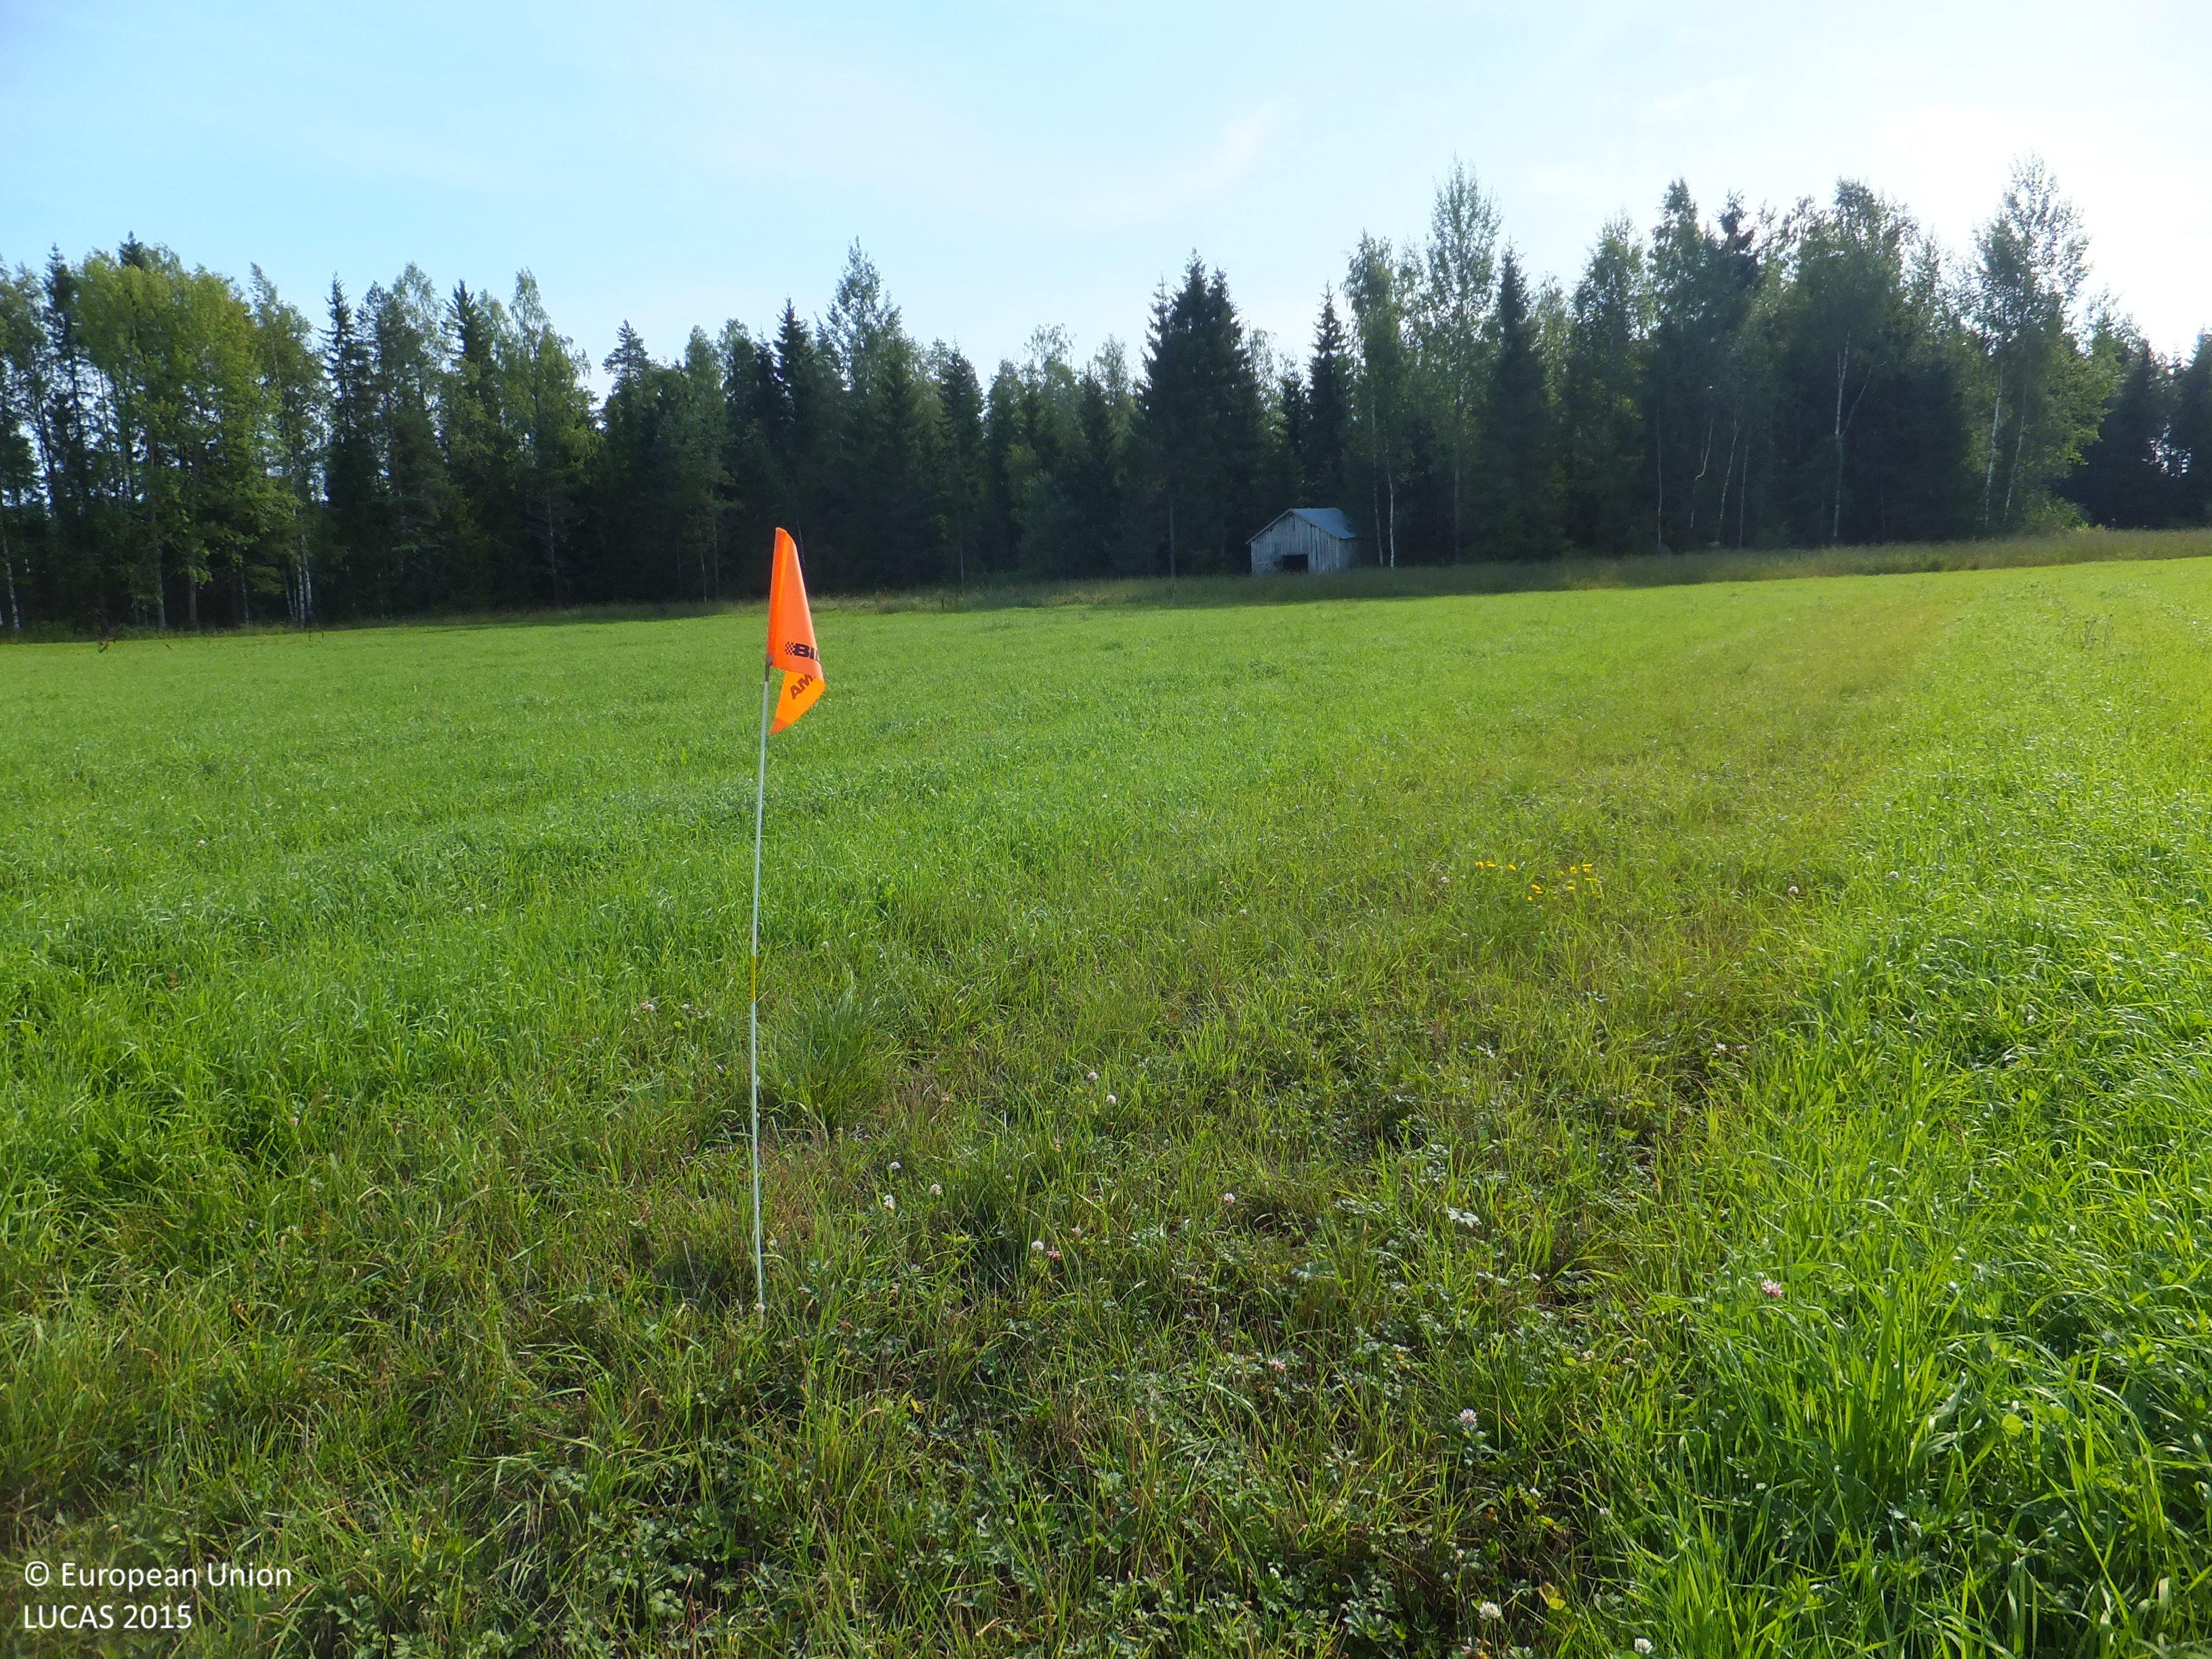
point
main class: Cropland
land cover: Temporary grasslands
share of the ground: > 75 %
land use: Agriculture (excluding fallow land and kitchen gardens)
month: August
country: FI
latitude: 63.3761
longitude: 22.8743
